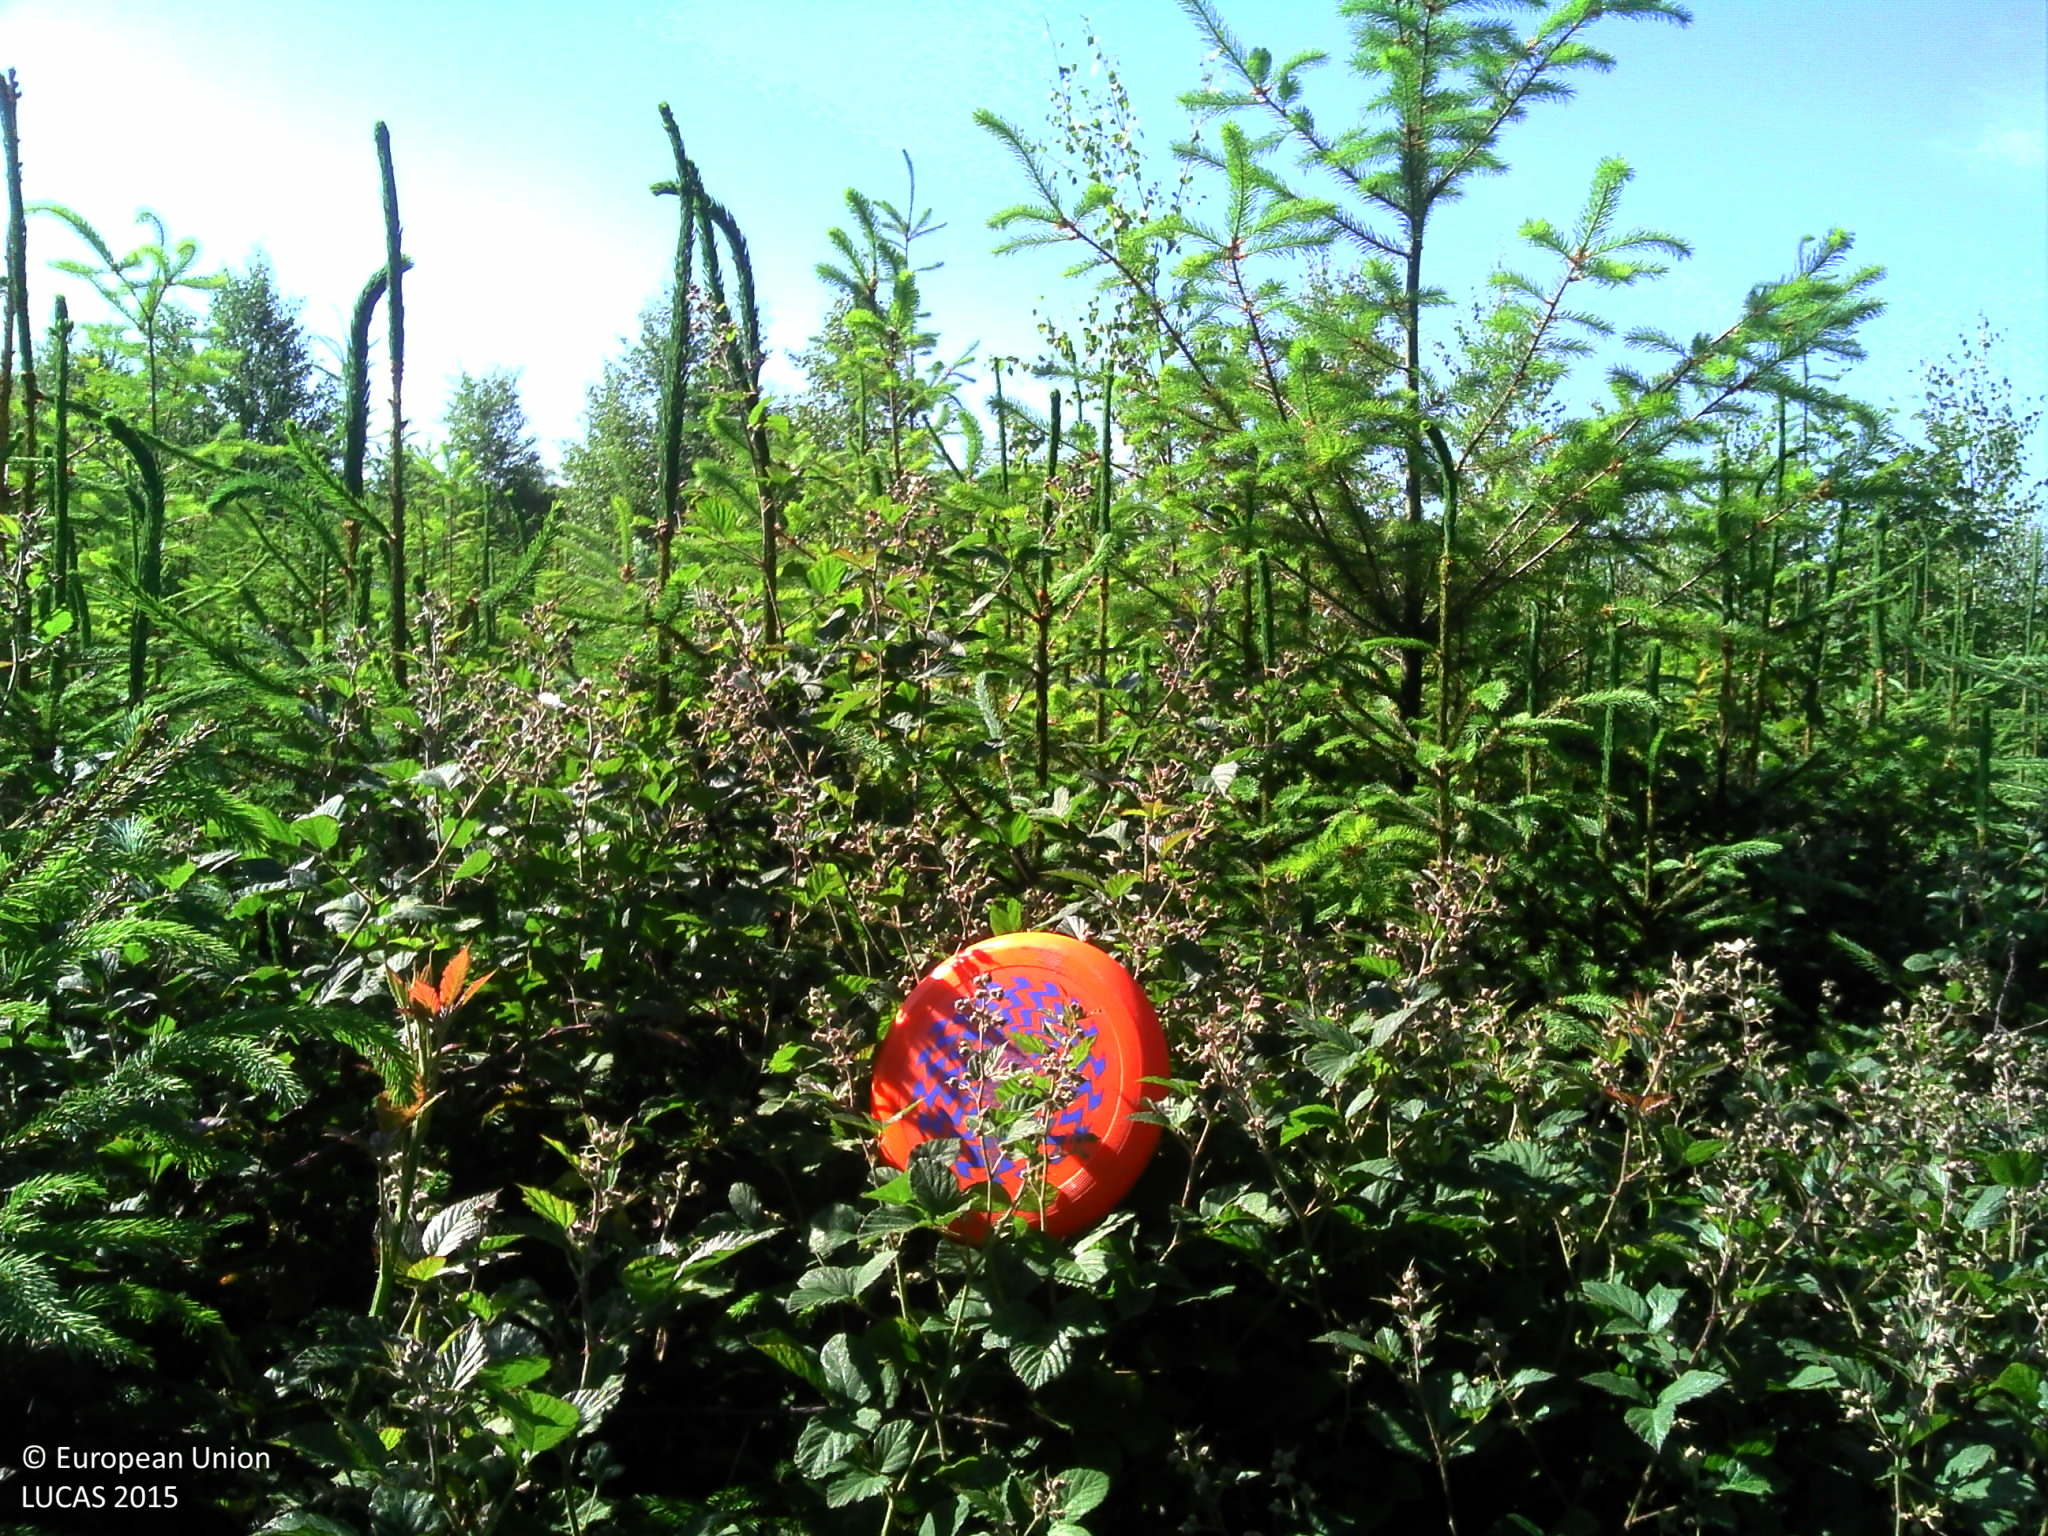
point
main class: Woodland
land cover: Other mixed woodland
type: acidophilous oak and oak-birch forest
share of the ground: 10 - 25 %
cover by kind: shrubs 50 %, herbaceous plants 30 %, coniferous forest trees 10 %, broadleaved forest trees 10 %
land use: Forestry
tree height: > 5 m
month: June
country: BE
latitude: 50.1968
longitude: 5.3331
